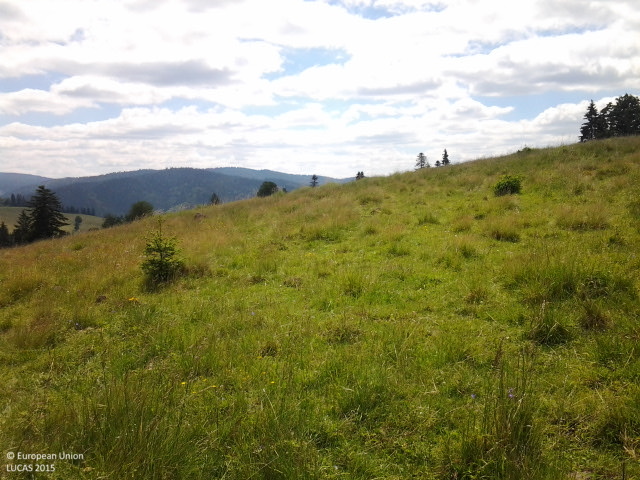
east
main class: Grassland
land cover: Grassland without tree/shrub cover
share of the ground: > 75 %
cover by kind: herbaceous plants 100 %
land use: Agriculture (excluding fallow land and kitchen gardens)
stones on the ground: 10 - 25 %
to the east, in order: Grassland without tree/shrub cover; Tracks; Grassland with sparse tree/shrub cover
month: June
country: RO
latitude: 47.0501
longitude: 25.3392
